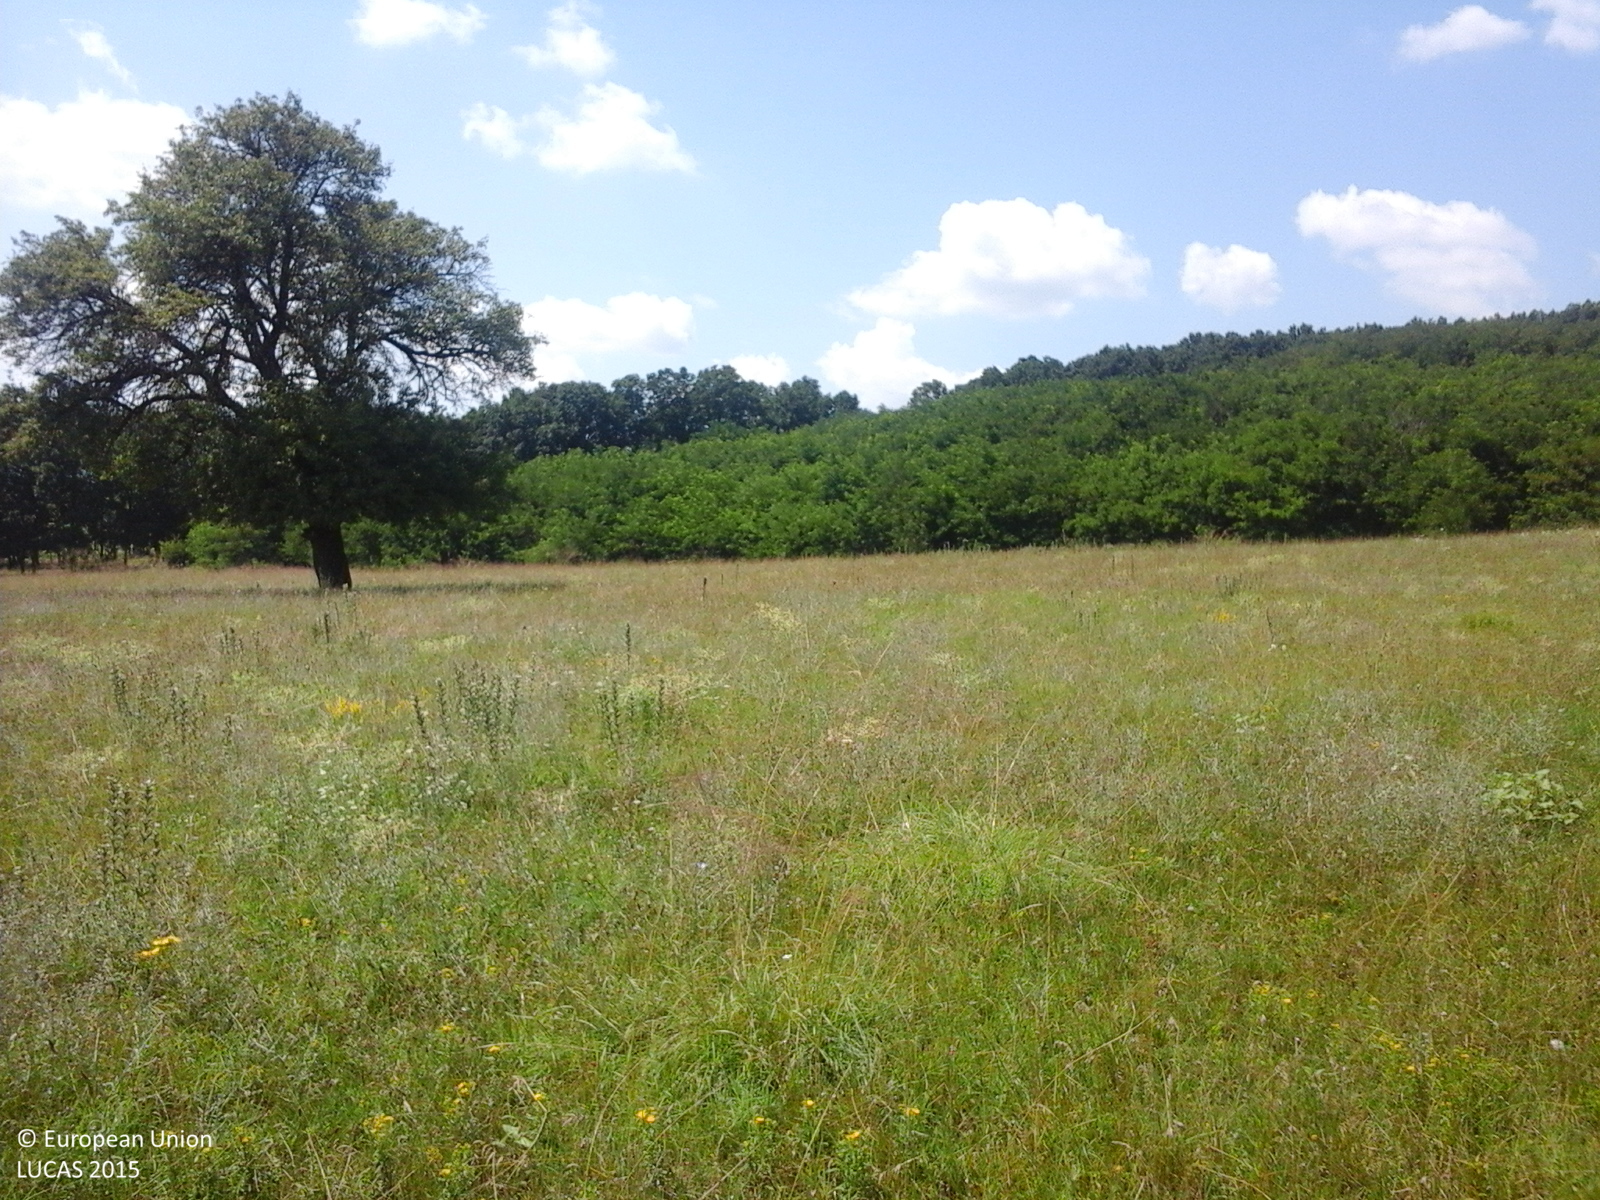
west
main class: Grassland
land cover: Grassland without tree/shrub cover
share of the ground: > 75 %
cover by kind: herbaceous plants 100 %
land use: Agriculture (excluding fallow land and kitchen gardens)
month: July
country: RO
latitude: 44.2038
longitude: 24.2417
